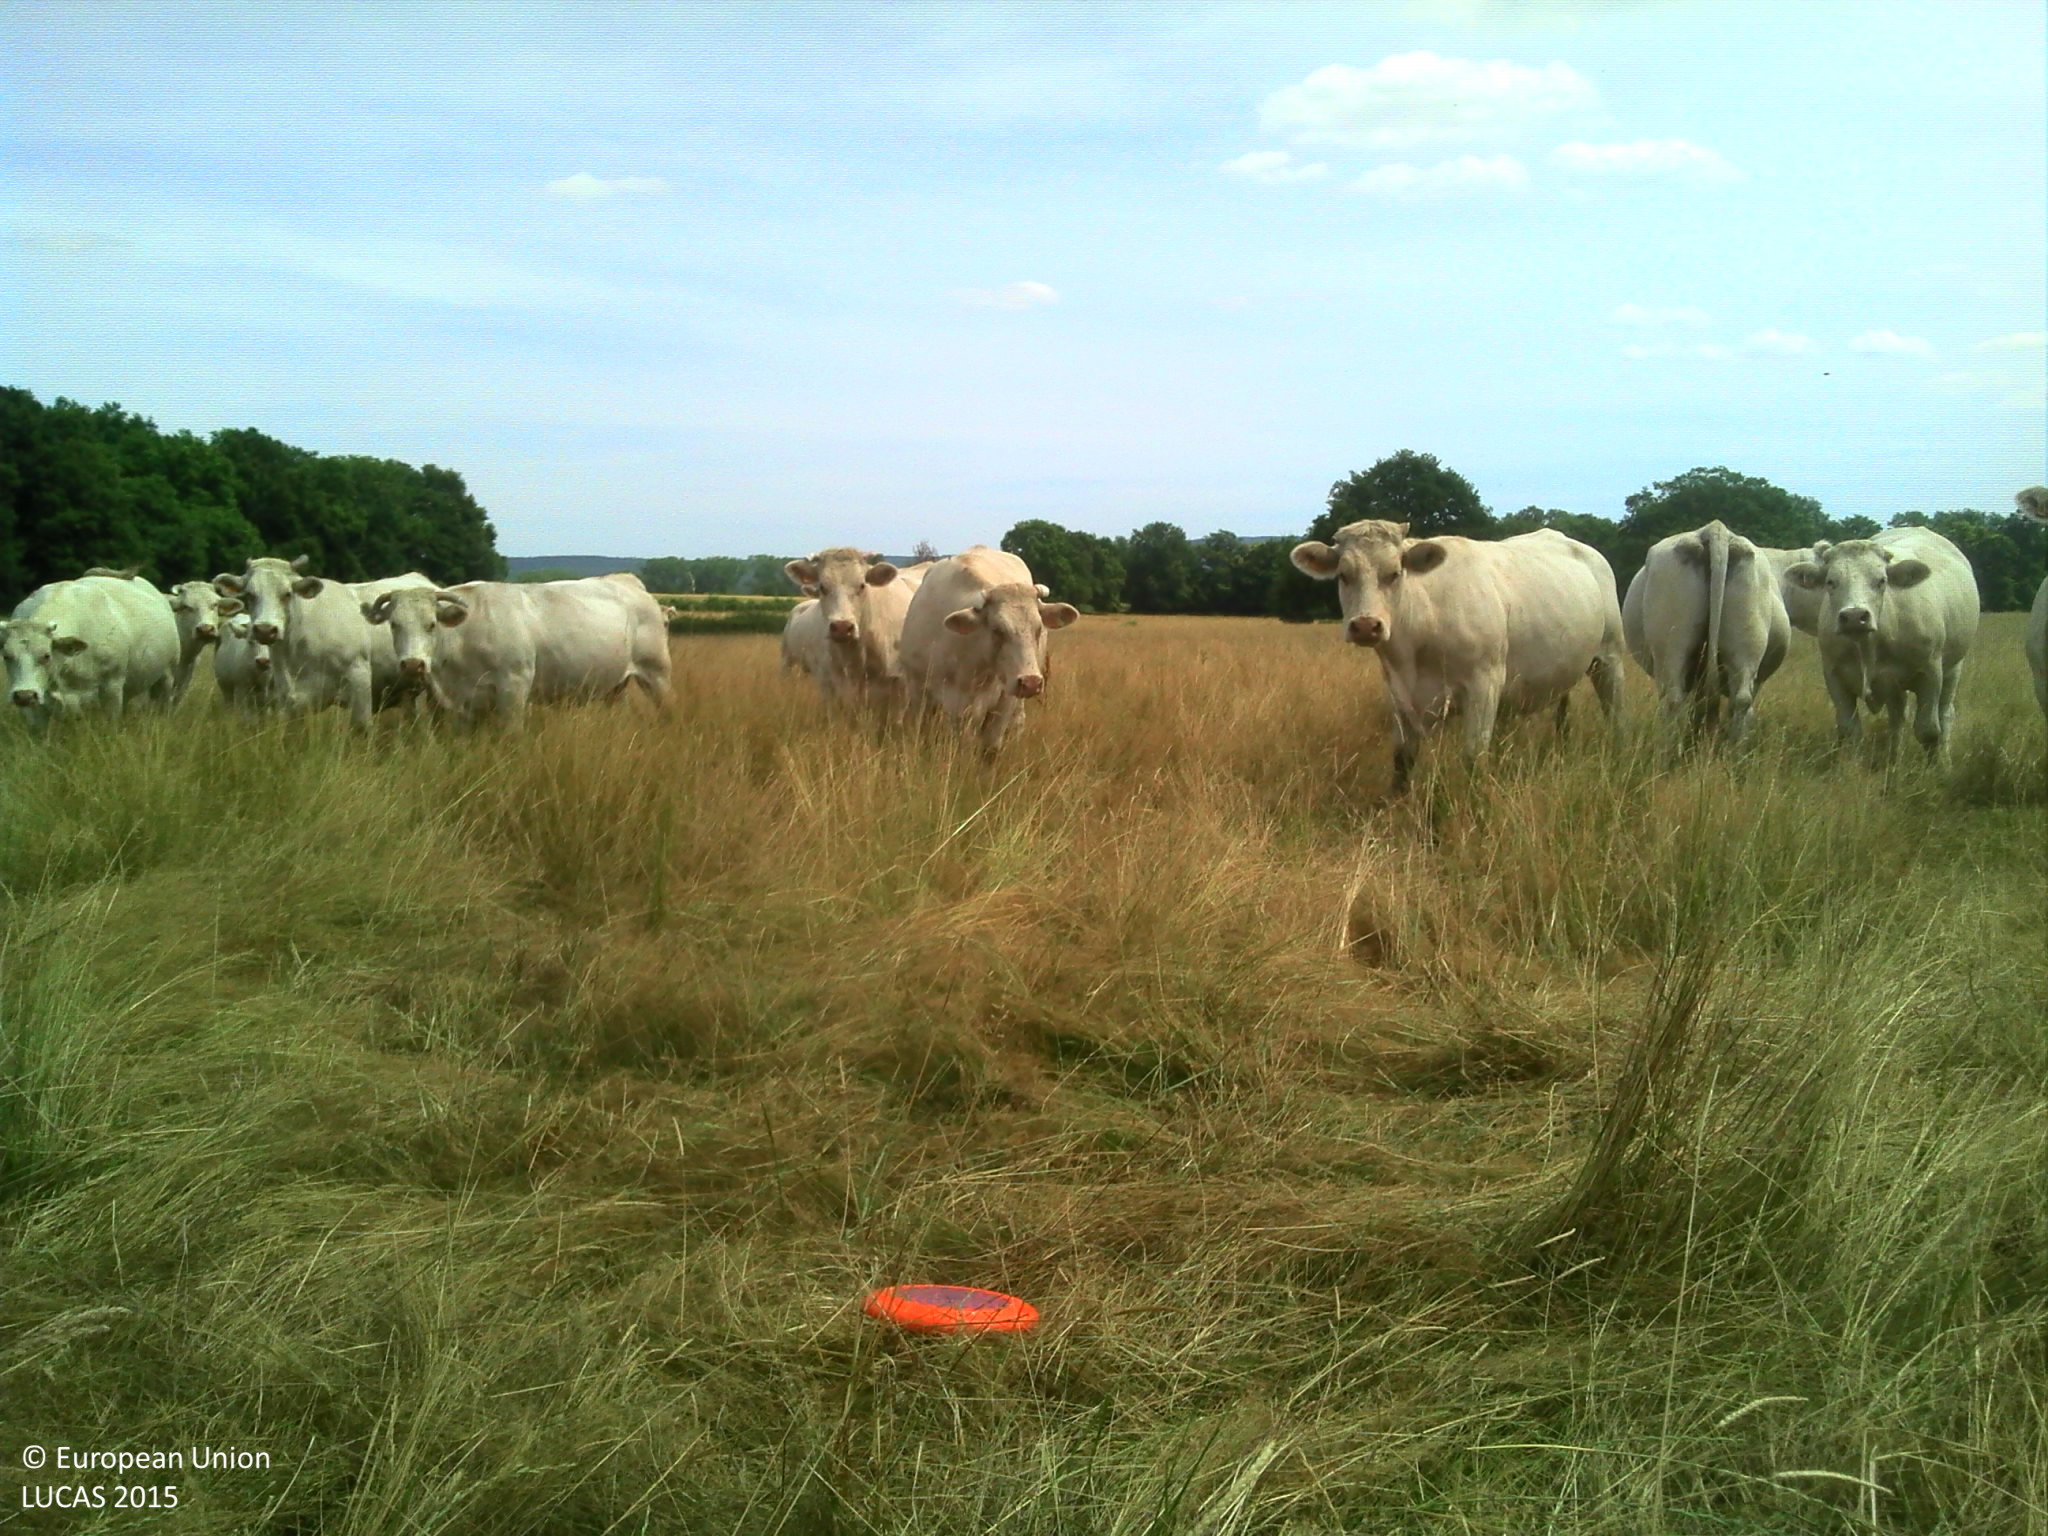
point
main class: Grassland
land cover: Grassland without tree/shrub cover
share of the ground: > 75 %
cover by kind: herbaceous plants 100 %
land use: Agriculture (excluding fallow land and kitchen gardens)
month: June
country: FR
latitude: 46.6560
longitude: 4.7613
